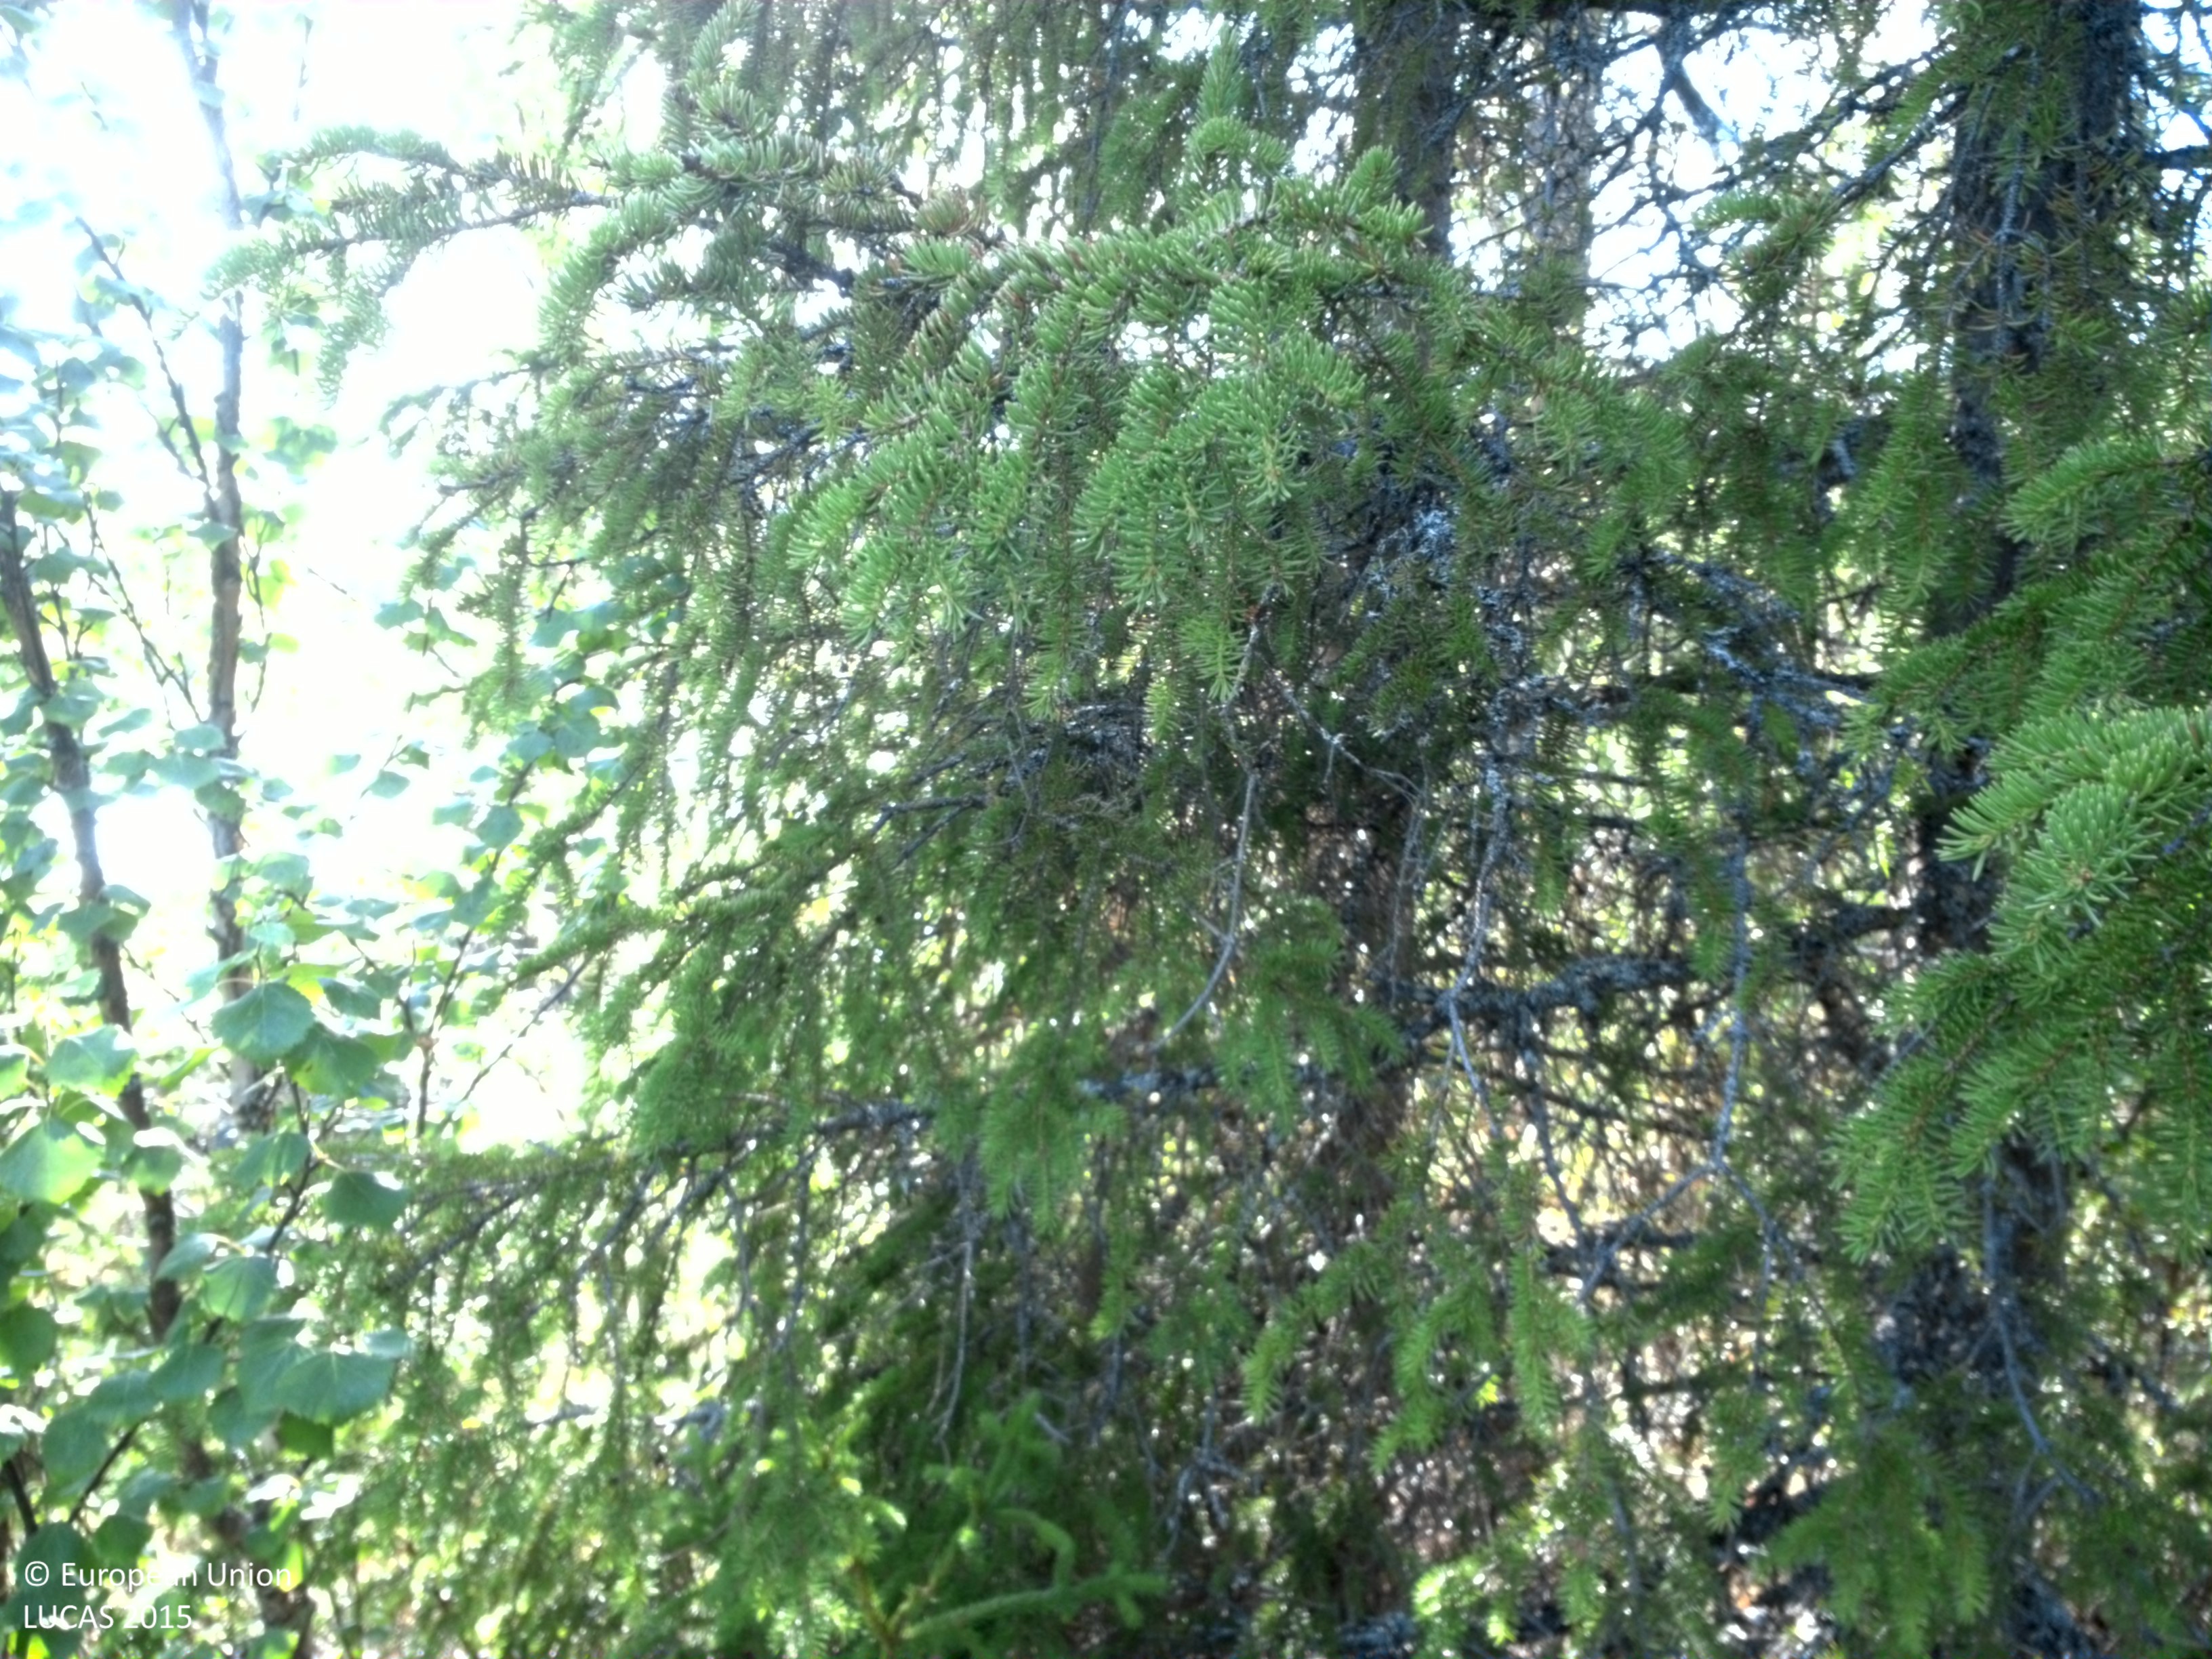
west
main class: Woodland
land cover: Spruce dominated mixed woodland
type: boreal forest
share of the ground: 25 - 50 %
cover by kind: shrubs 50 %, broadleaved forest trees 30 %, coniferous forest trees 10 %, lichens and mosses 10 %
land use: Forestry
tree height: > 5 m
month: August
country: SE
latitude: 65.0926
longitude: 16.1999
